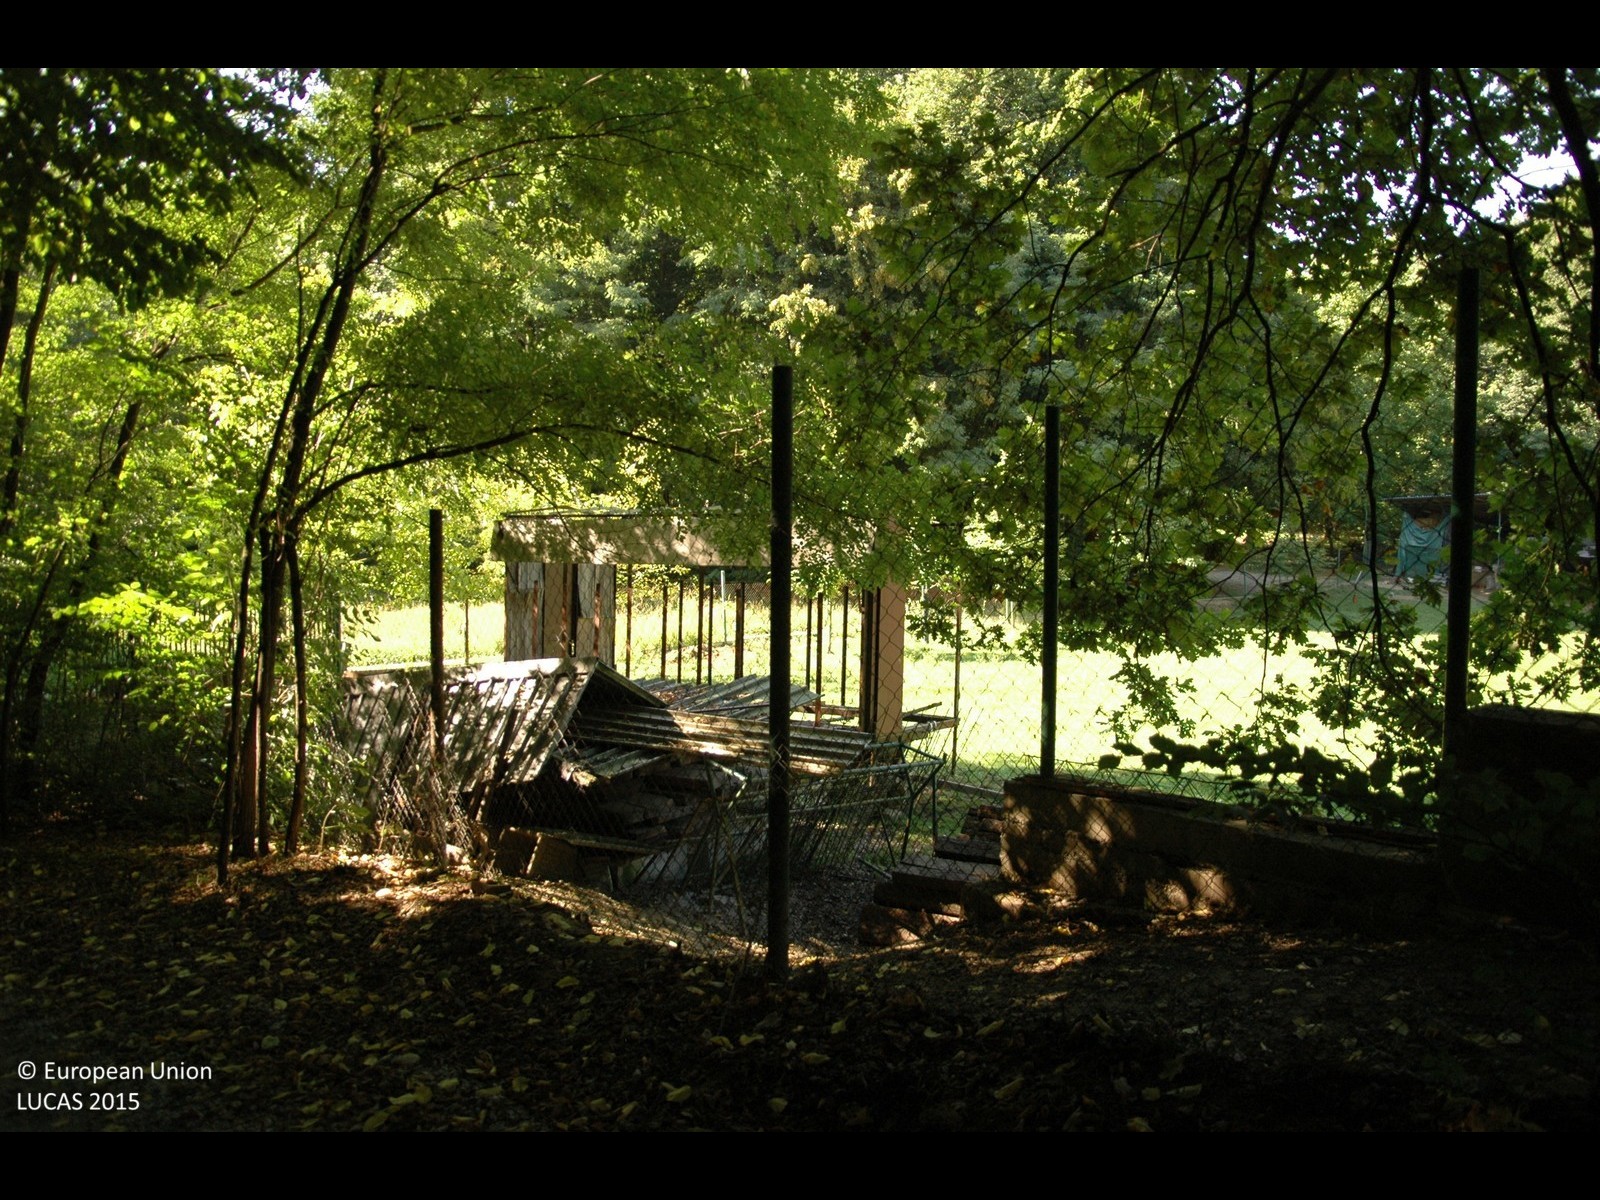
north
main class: Woodland
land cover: Broadleaved woodland
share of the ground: > 75 %
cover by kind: broadleaved forest trees 100 %
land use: Semi-natural and natural areas not in use
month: August
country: HR
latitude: 46.1724
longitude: 16.7753
